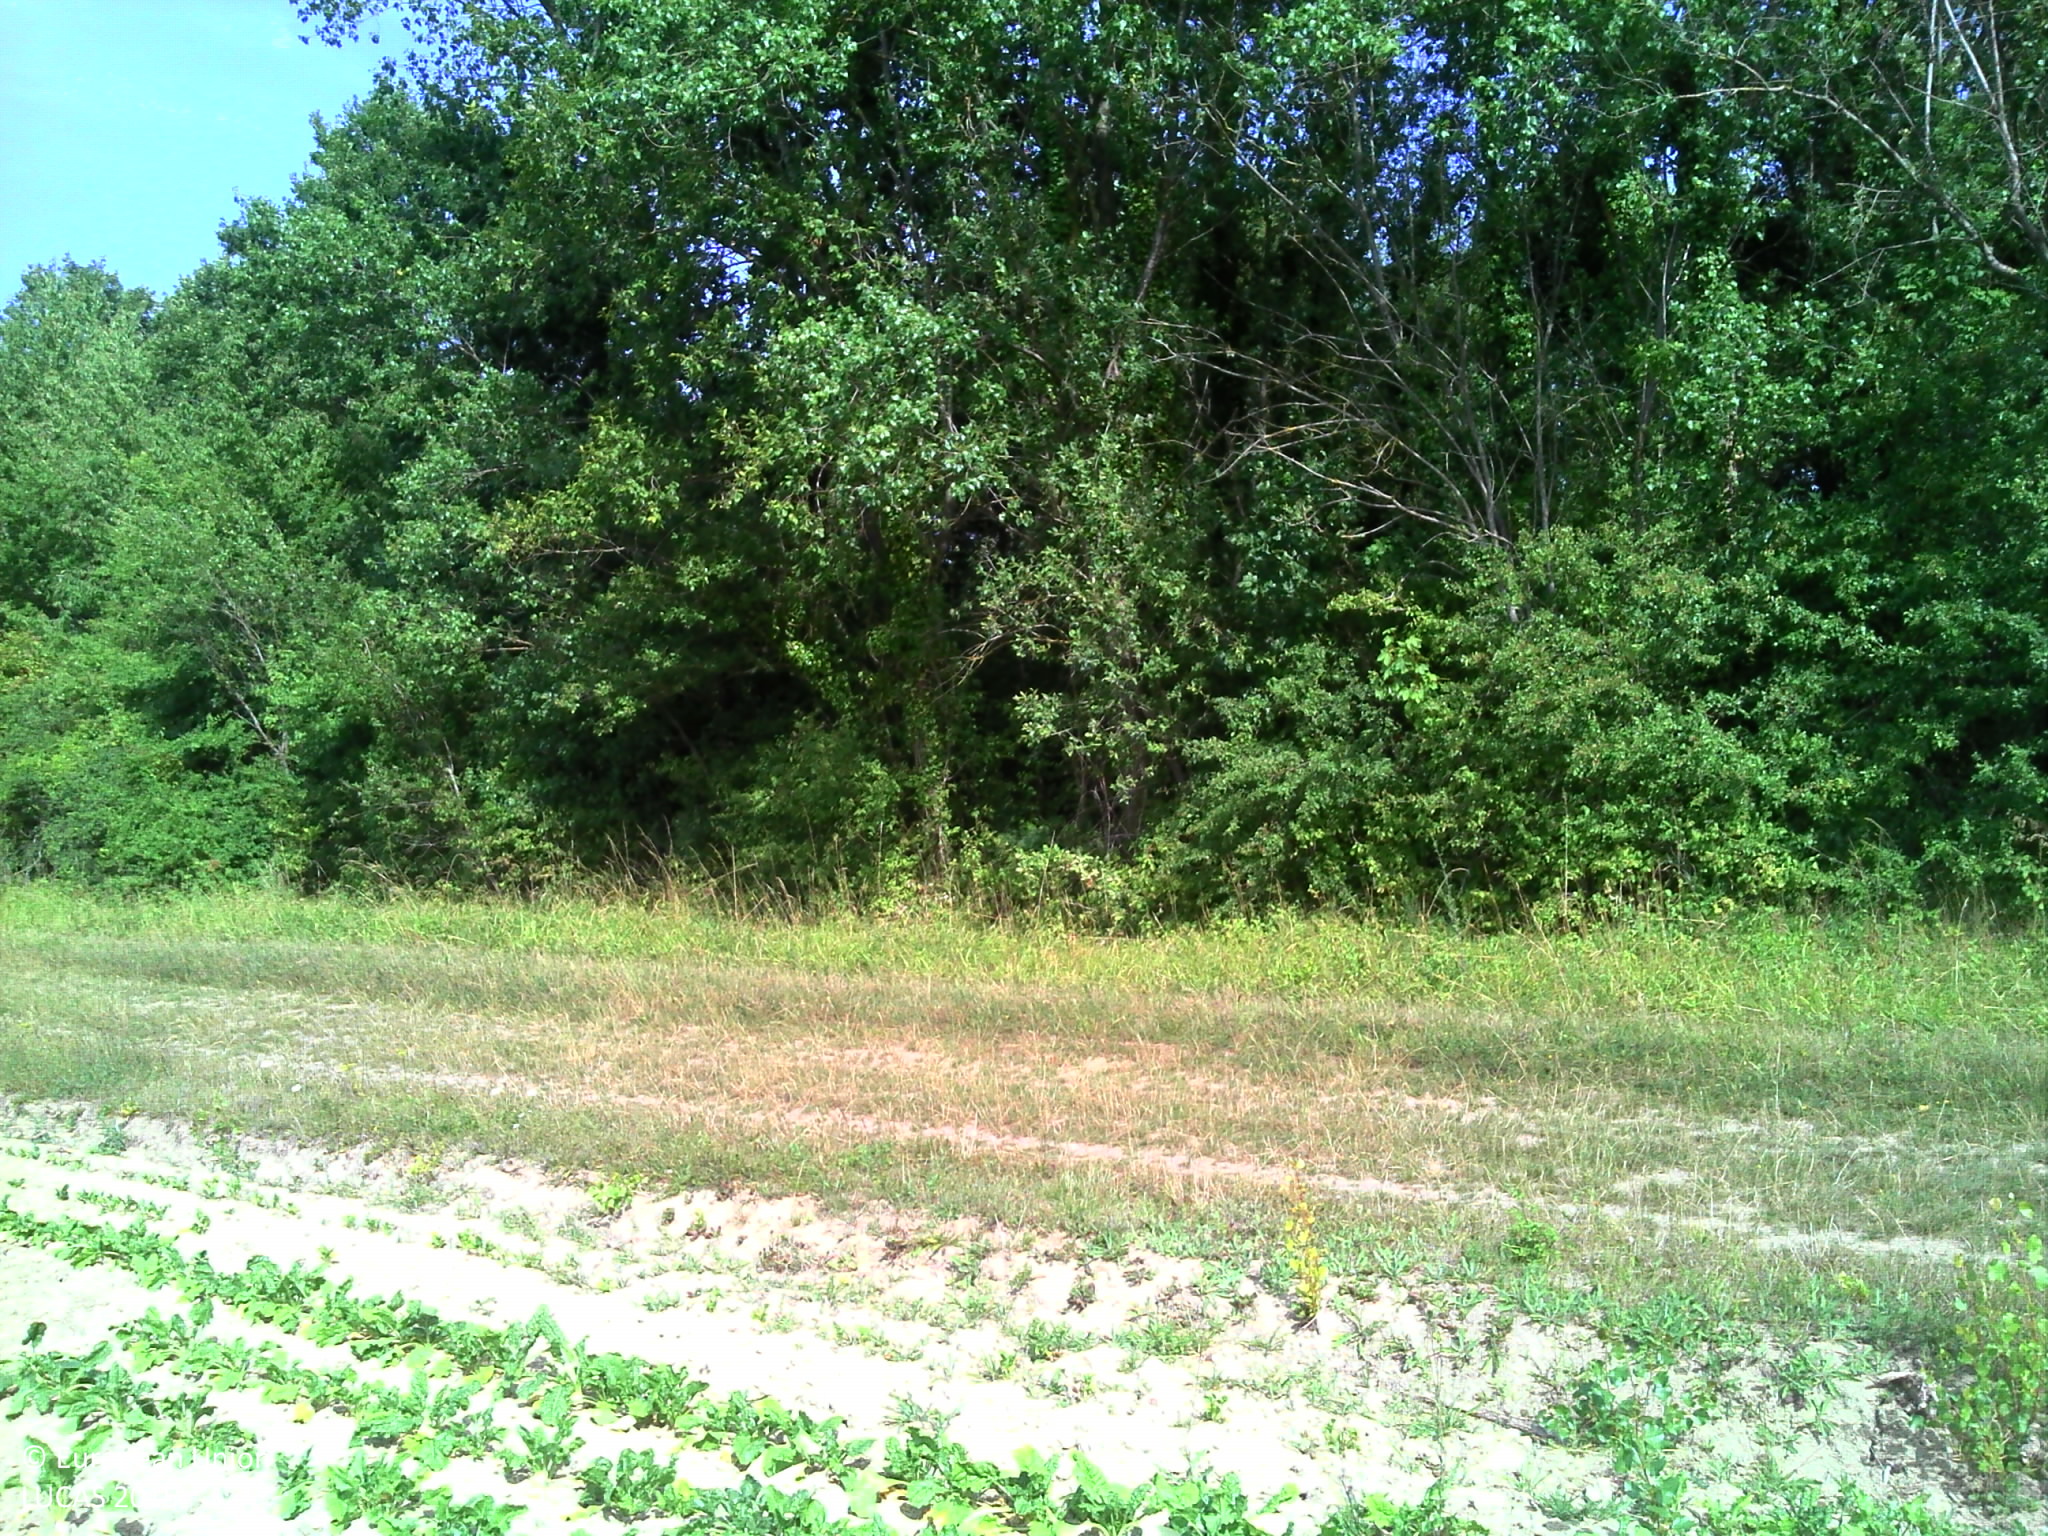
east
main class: Cropland
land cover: Sugar beet
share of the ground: > 75 %
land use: Agriculture (excluding fallow land and kitchen gardens)
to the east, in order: Sugar beet; Grass margins; Tracks; Grass margins; Broadleaved woodland; Grass margins; Rape and turnip rape
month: July
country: FR
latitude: 48.5724
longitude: 3.8013
